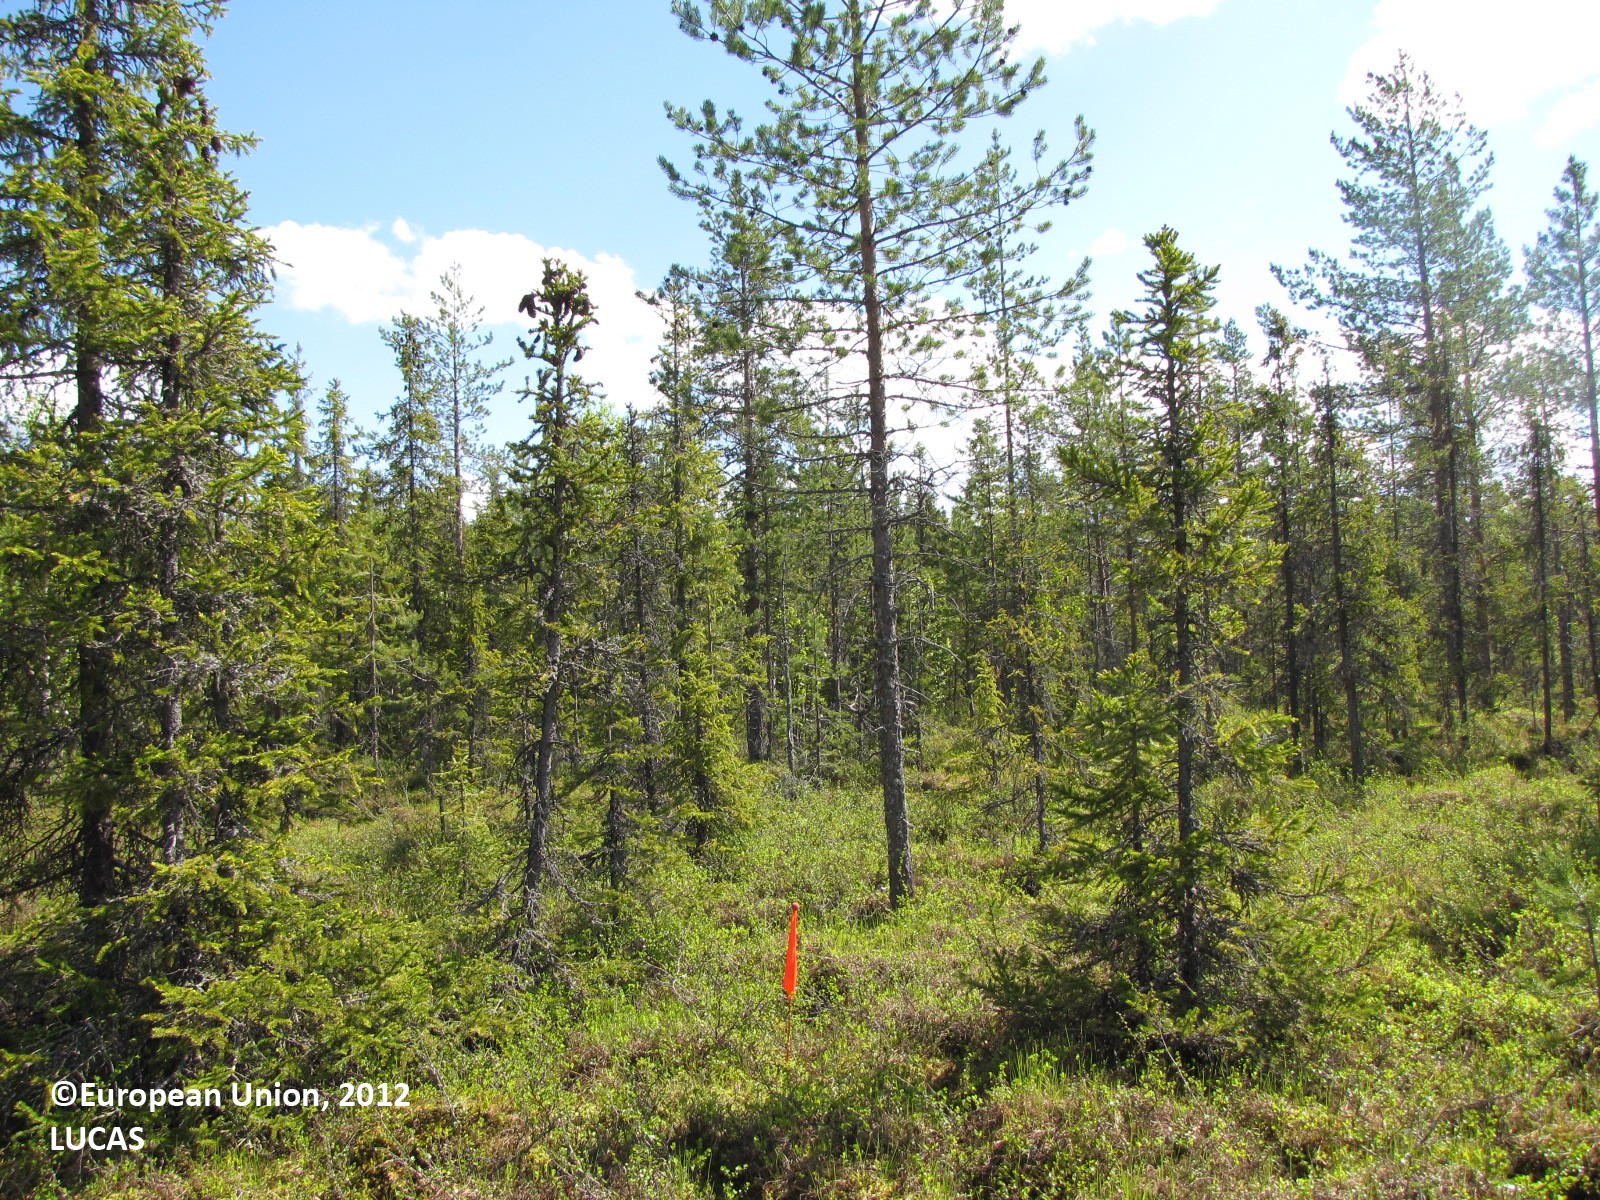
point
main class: Woodland
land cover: Spruce dominated coniferous woodland
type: boreal forest
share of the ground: 25 - 50 %
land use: Forestry
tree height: > 5 m
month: June
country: FI
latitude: 65.9757
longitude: 24.7380
